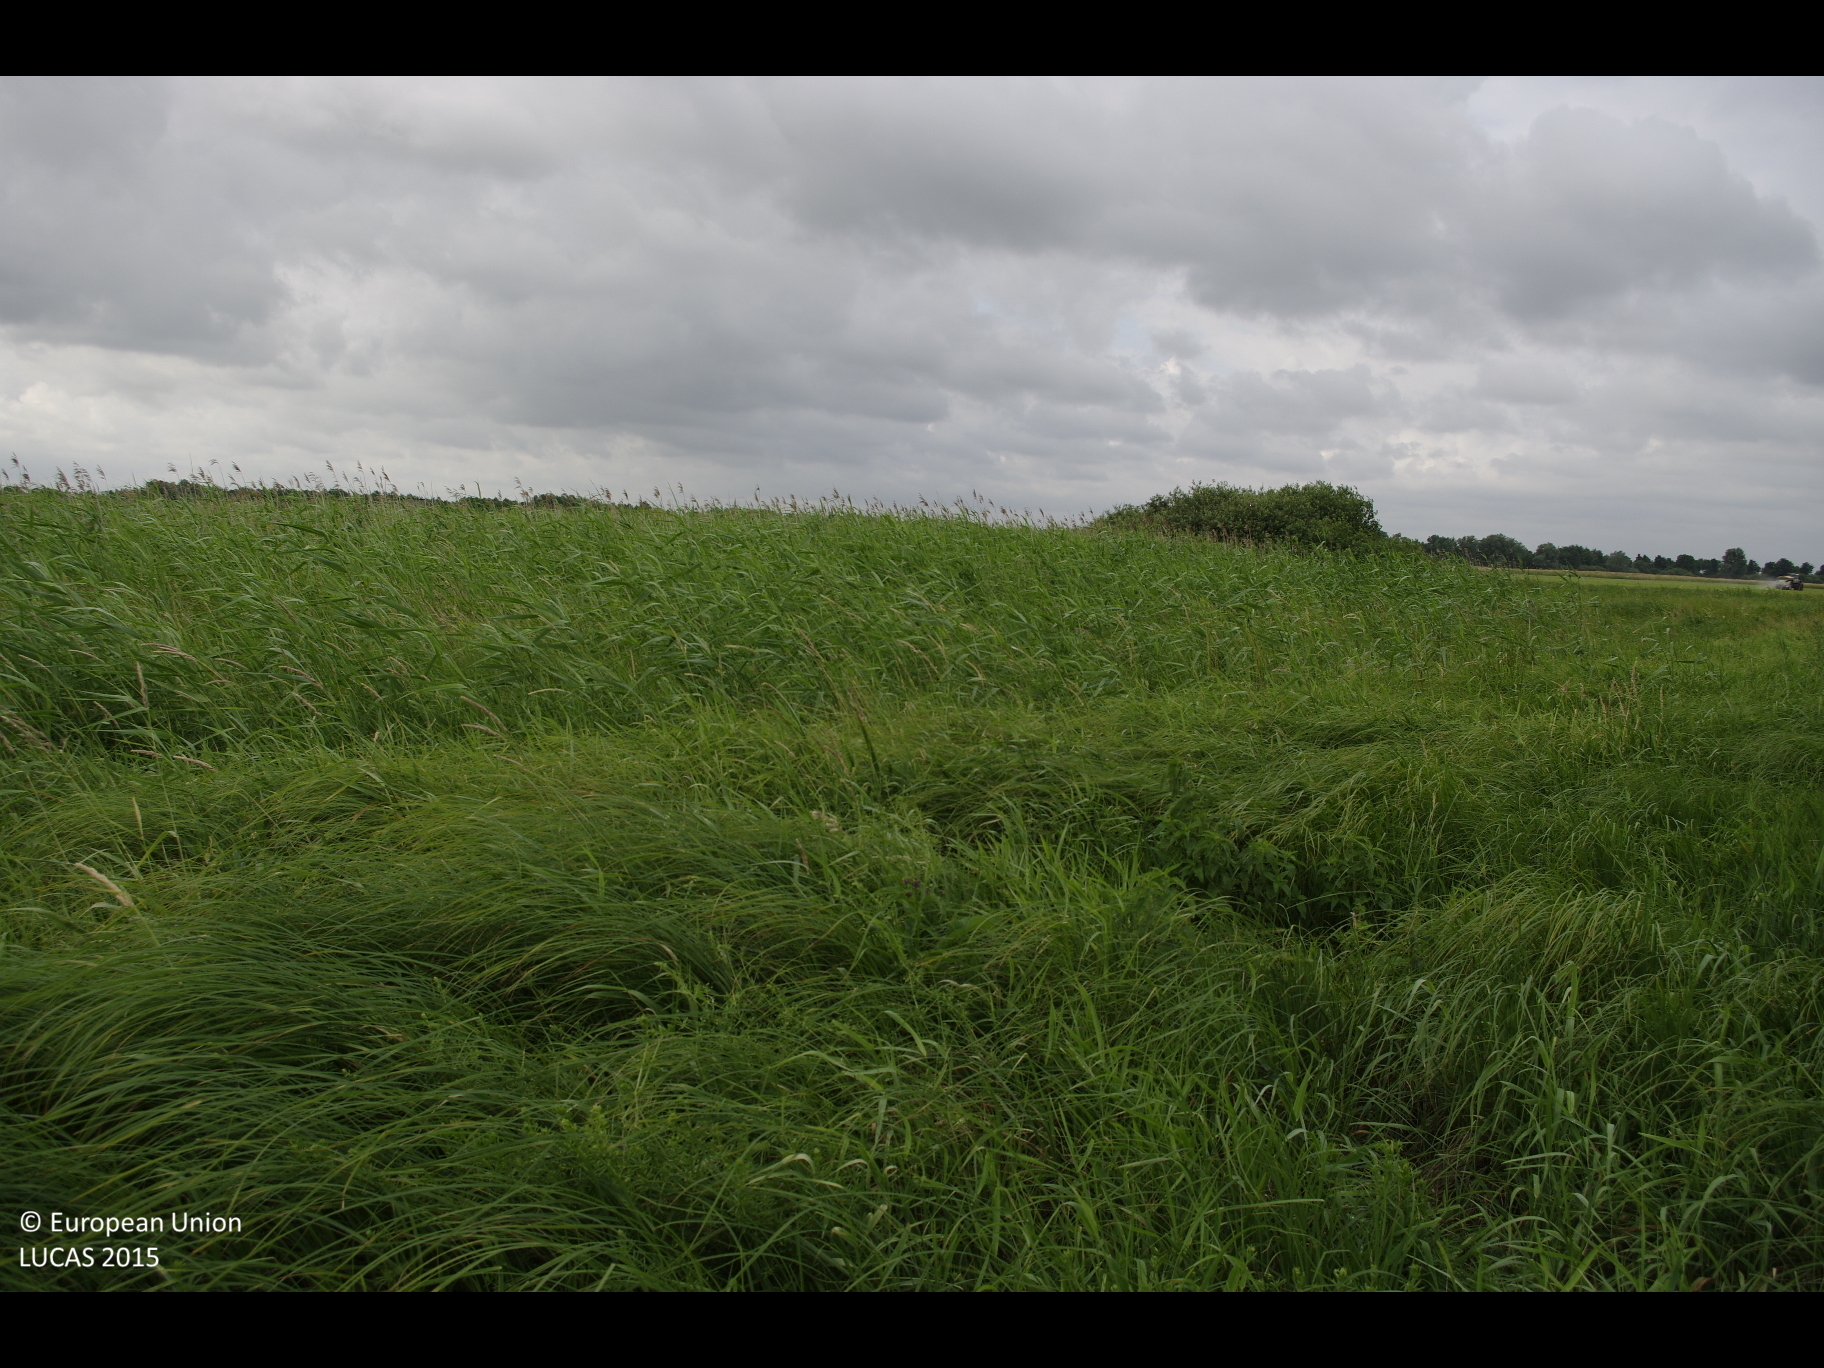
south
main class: Grassland
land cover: Grassland without tree/shrub cover
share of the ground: > 75 %
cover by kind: herbaceous plants 100 %
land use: Semi-natural and natural areas not in use
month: July
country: DE
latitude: 53.3824
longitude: 10.6161
